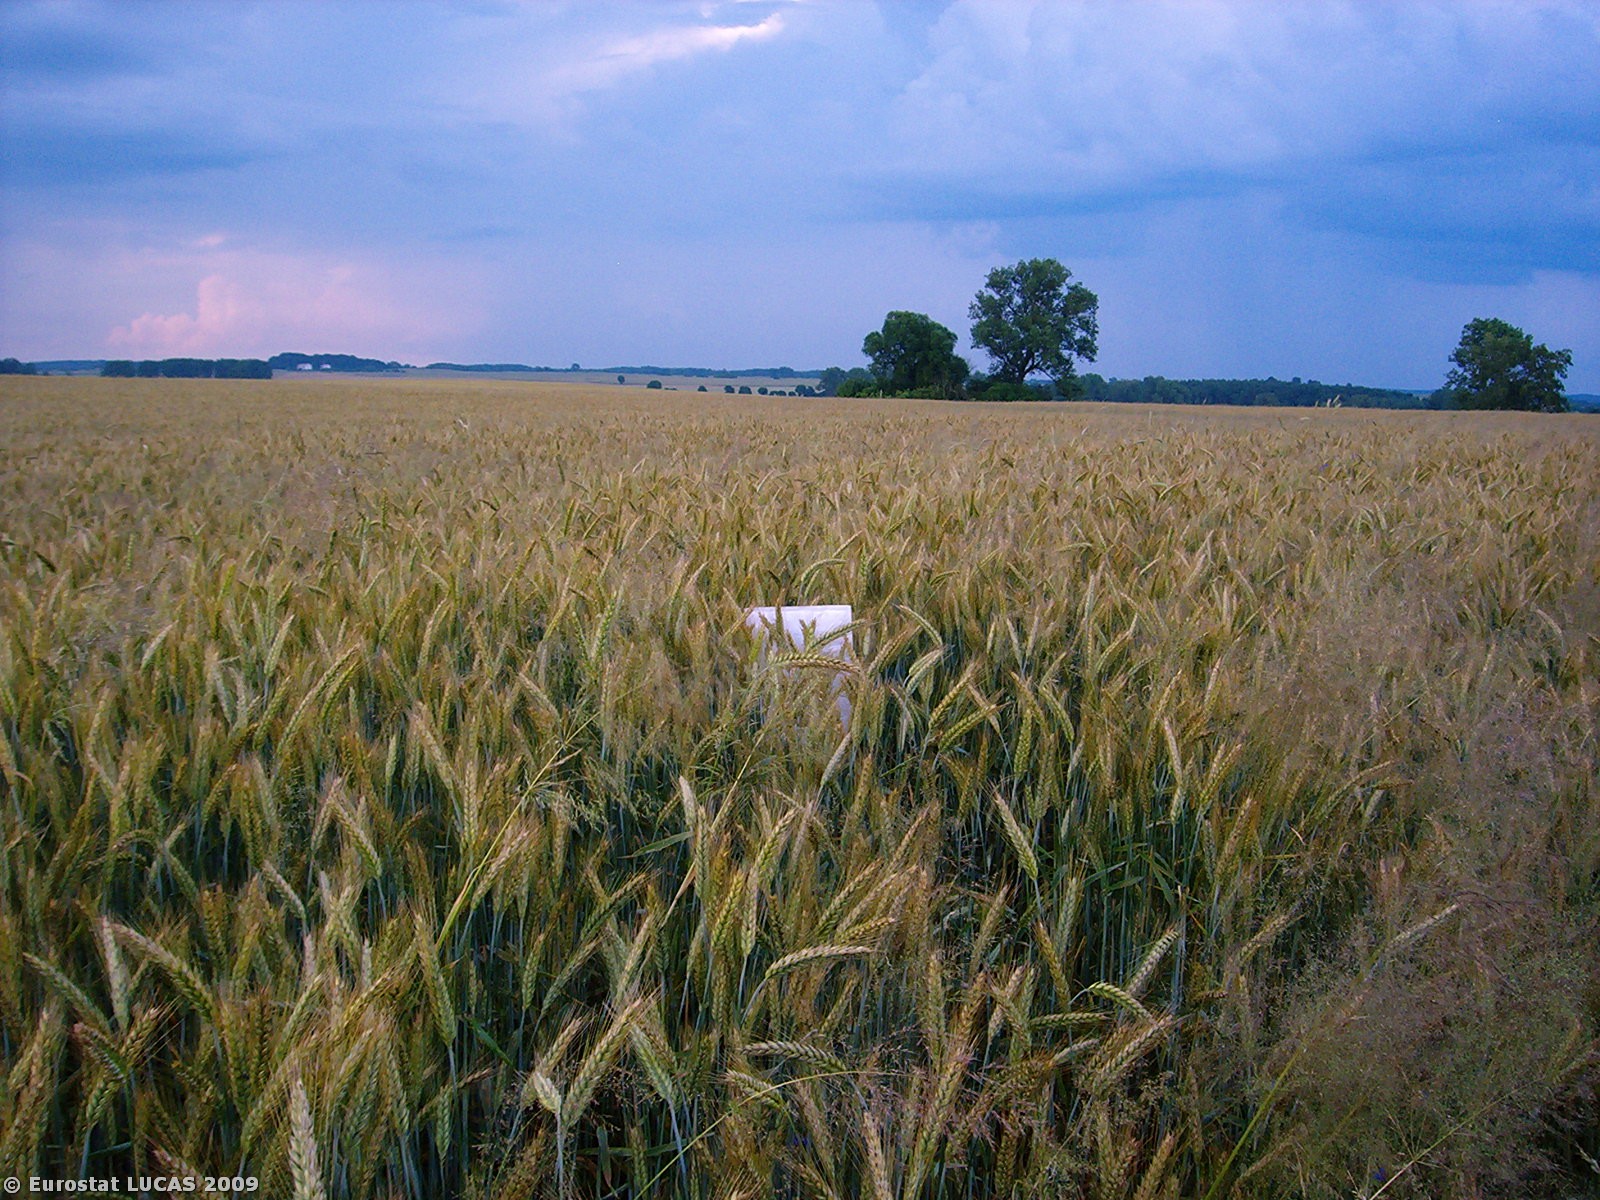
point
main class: Cropland
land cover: Triticale
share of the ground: > 75 %
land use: Agriculture (excluding fallow land and kitchen gardens)
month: July
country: PL
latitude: 53.2601
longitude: 15.4751
